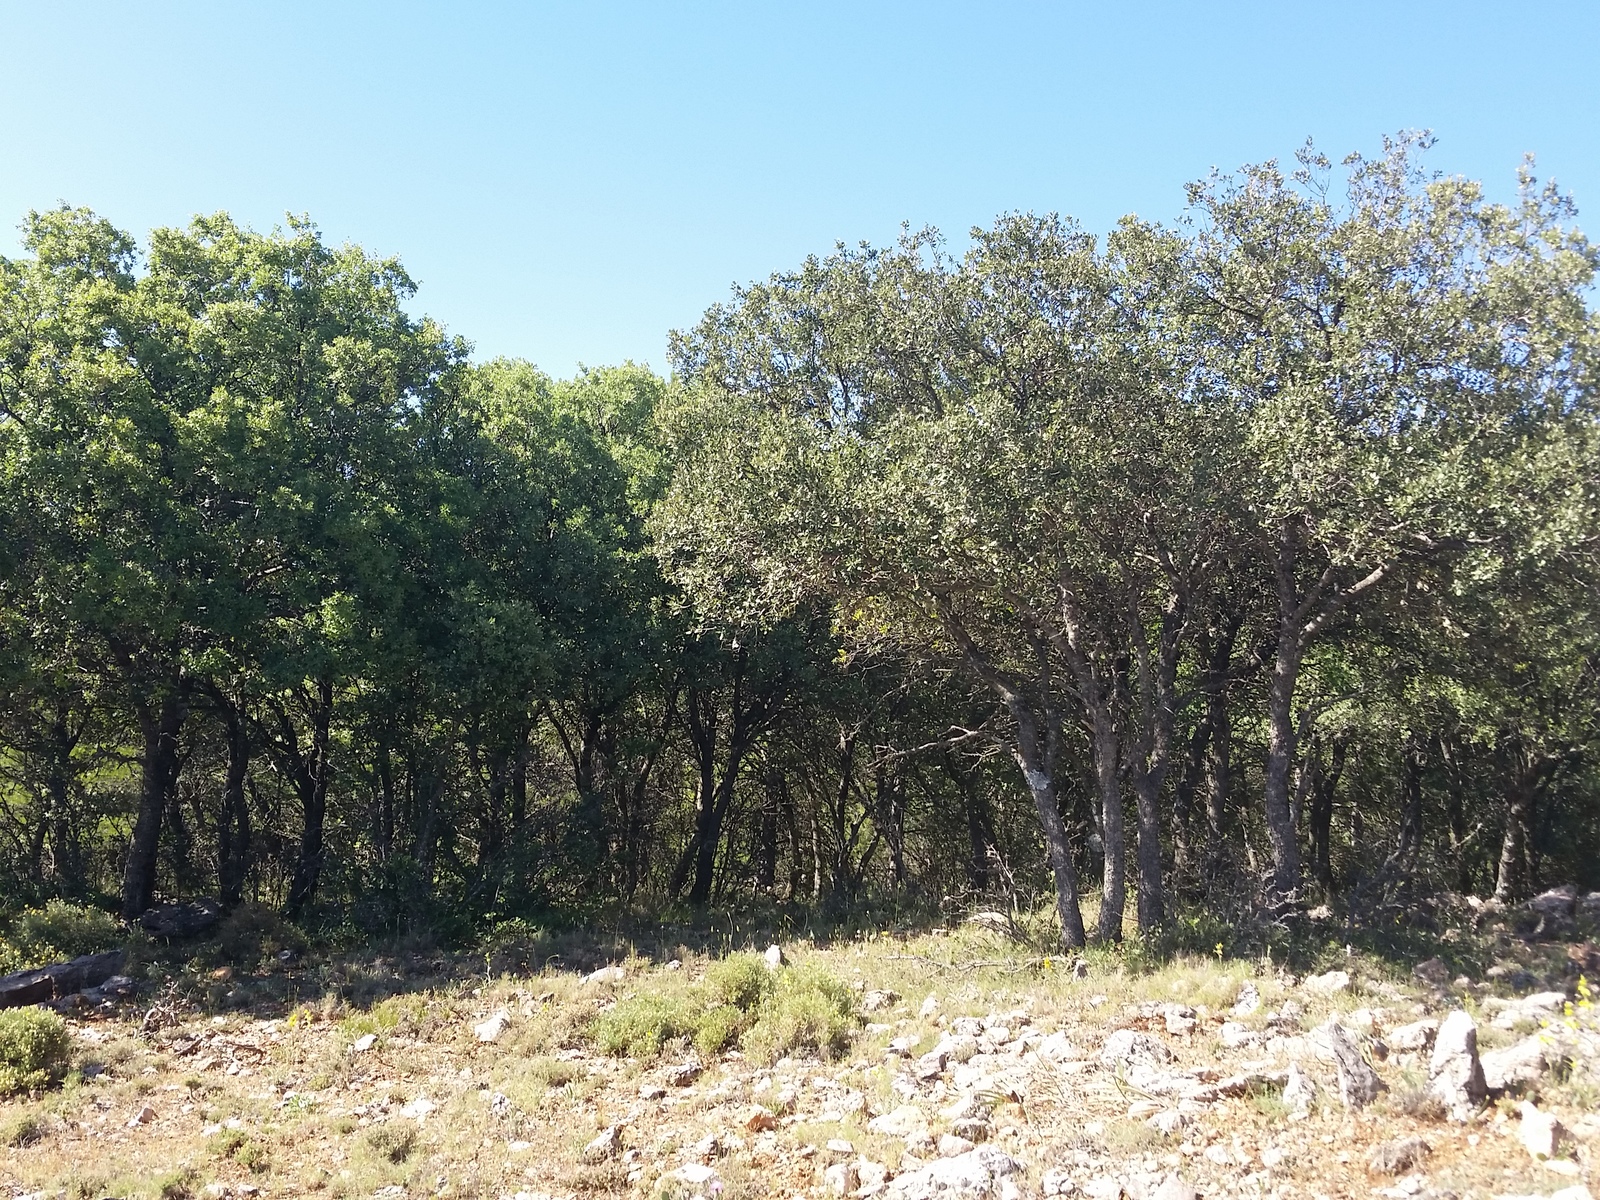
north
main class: Woodland
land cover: Pine dominated coniferous woodland
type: coniferous forest of the mediterranean region
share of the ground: 50 - 75 %
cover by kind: coniferous forest trees 60 %, shrubs 30 %, herbaceous plants 5 %, consolidated bare surface 5 %
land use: Semi-natural and natural areas not in use
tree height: > 5 m
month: June
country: ES
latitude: 38.5414
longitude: -2.5630
